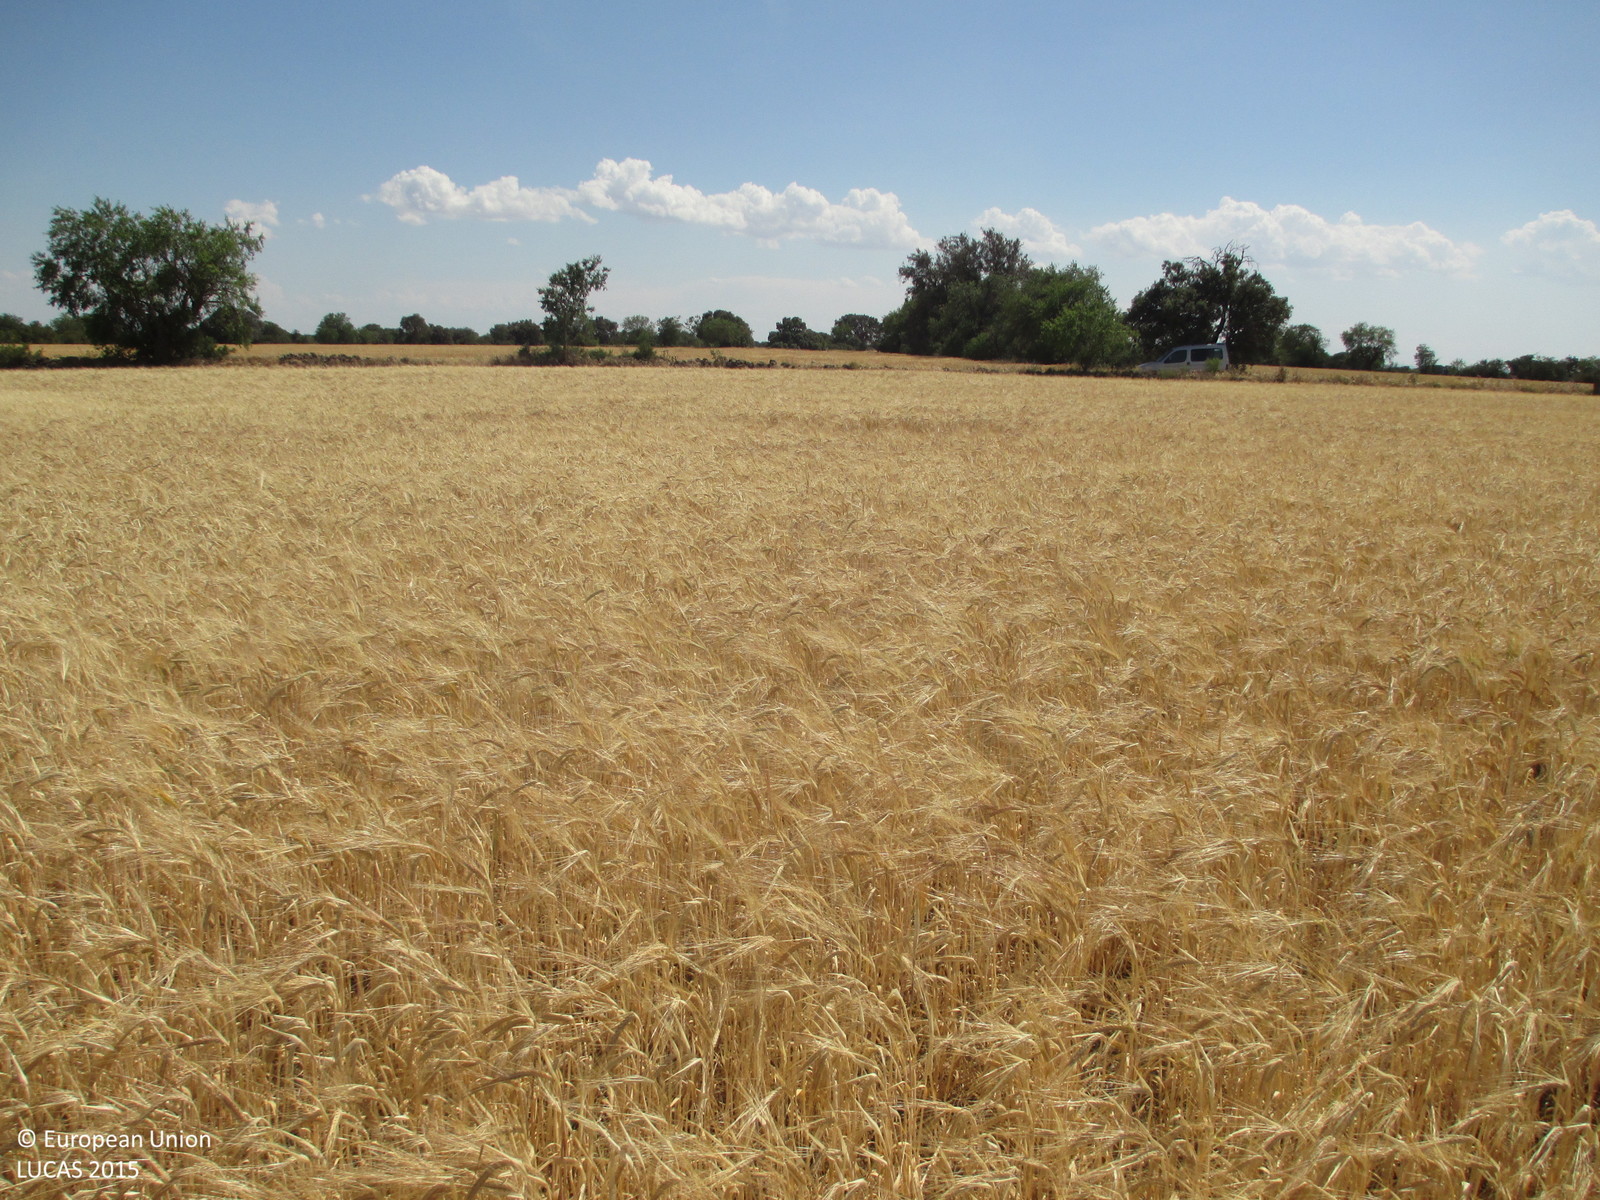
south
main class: Cropland
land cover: Barley
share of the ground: > 75 %
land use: Agriculture (excluding fallow land and kitchen gardens)
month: May
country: ES
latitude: 41.9225
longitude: 0.0099
